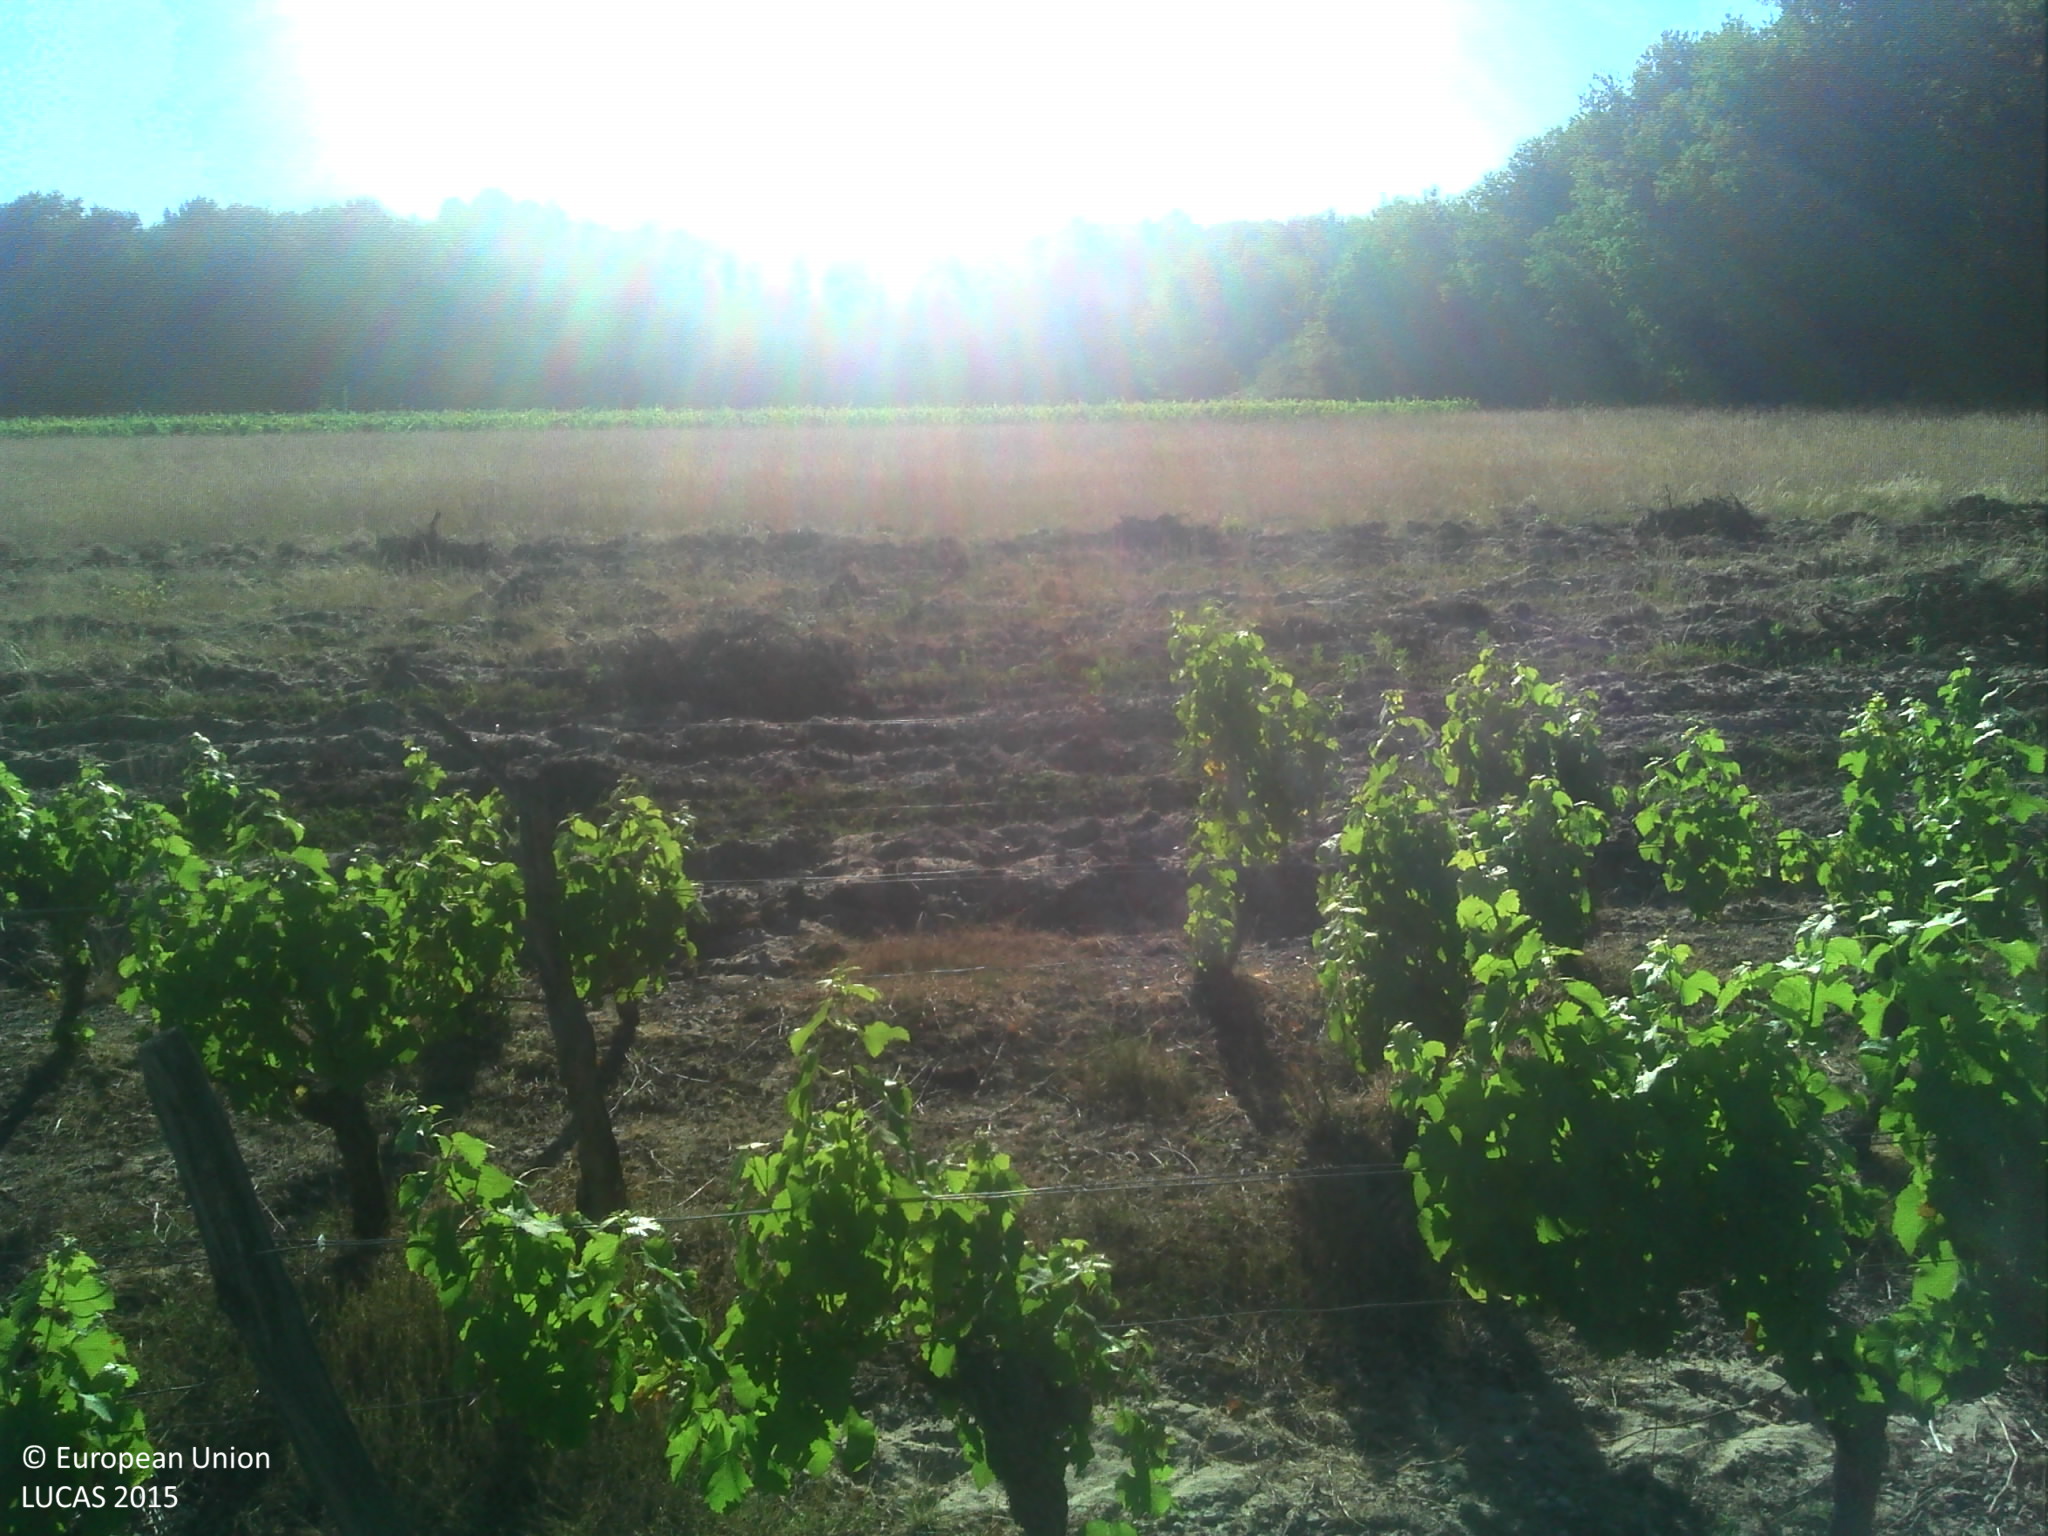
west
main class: Cropland
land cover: Vineyards
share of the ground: 25 - 50 %
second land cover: Spontaneously vegetated surfaces
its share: > 75 %
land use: Agriculture (excluding fallow land and kitchen gardens)
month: June
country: FR
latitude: 47.3342
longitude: 1.5039
